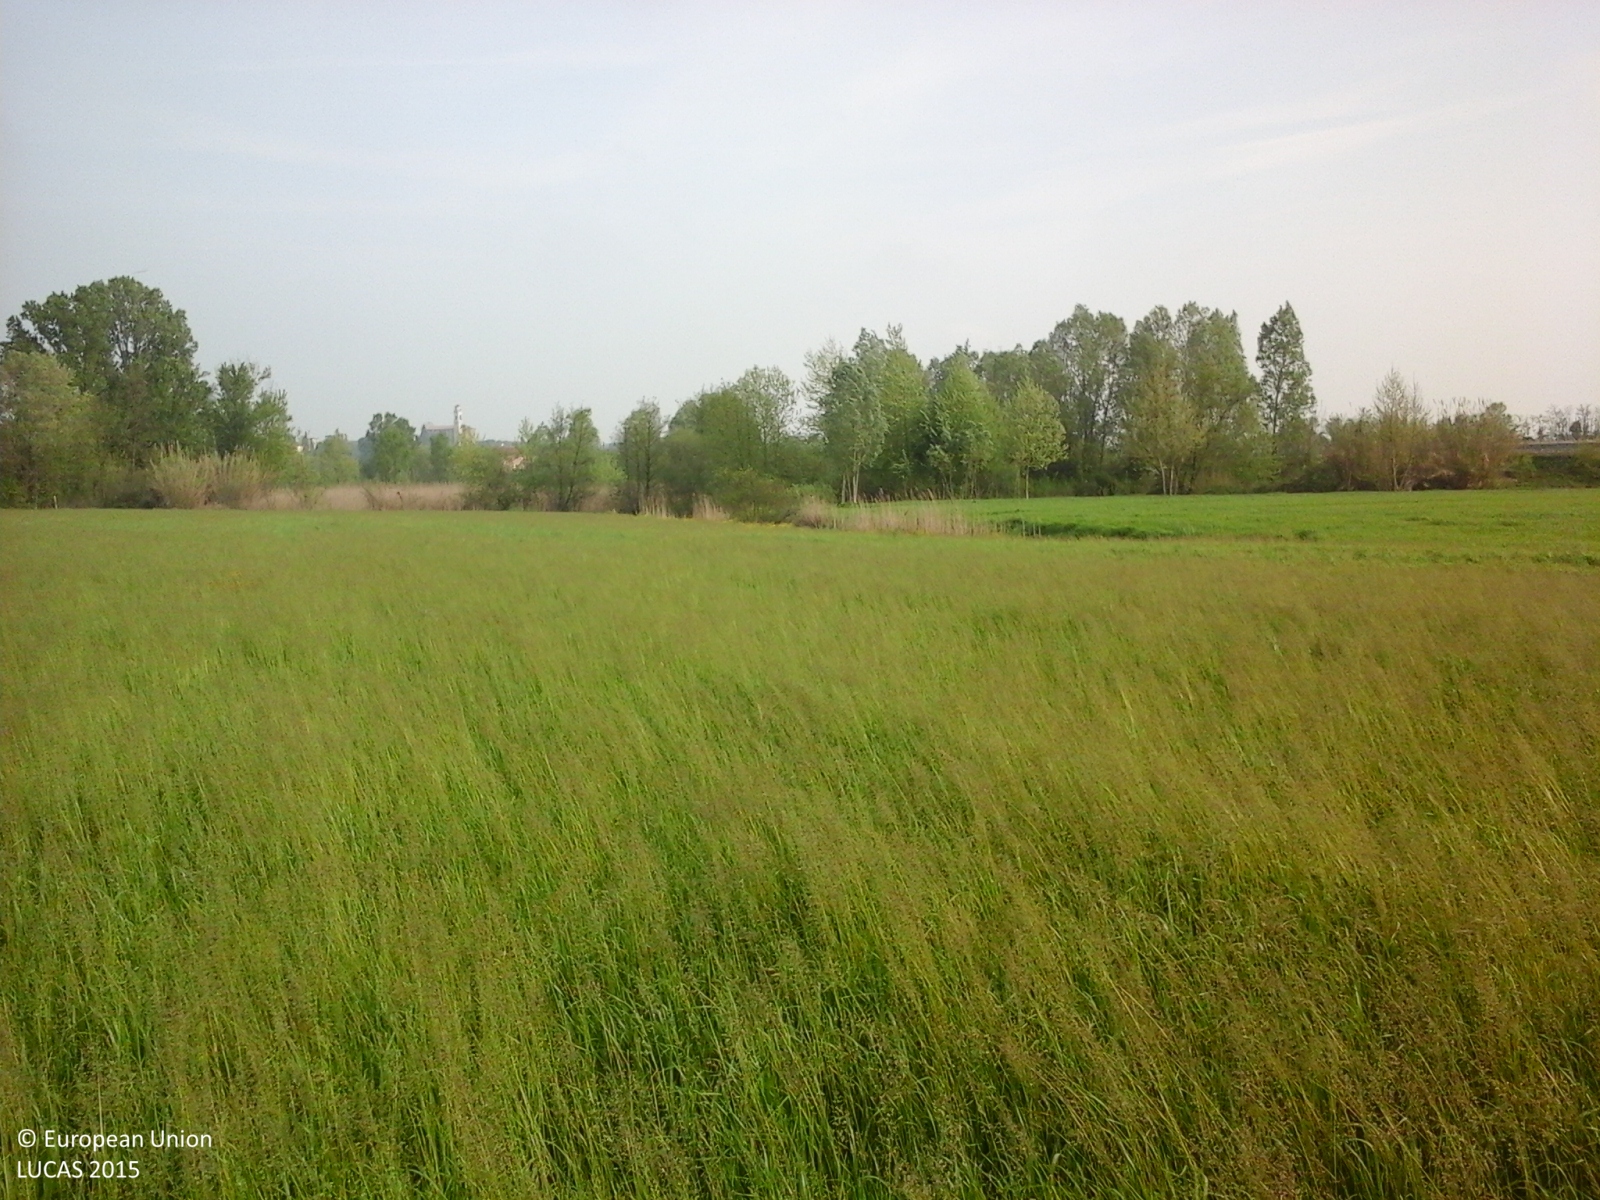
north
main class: Grassland
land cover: Grassland without tree/shrub cover
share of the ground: > 75 %
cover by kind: herbaceous plants 100 %
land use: Agriculture (excluding fallow land and kitchen gardens)
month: April
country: IT
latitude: 45.3759
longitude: 10.7011
